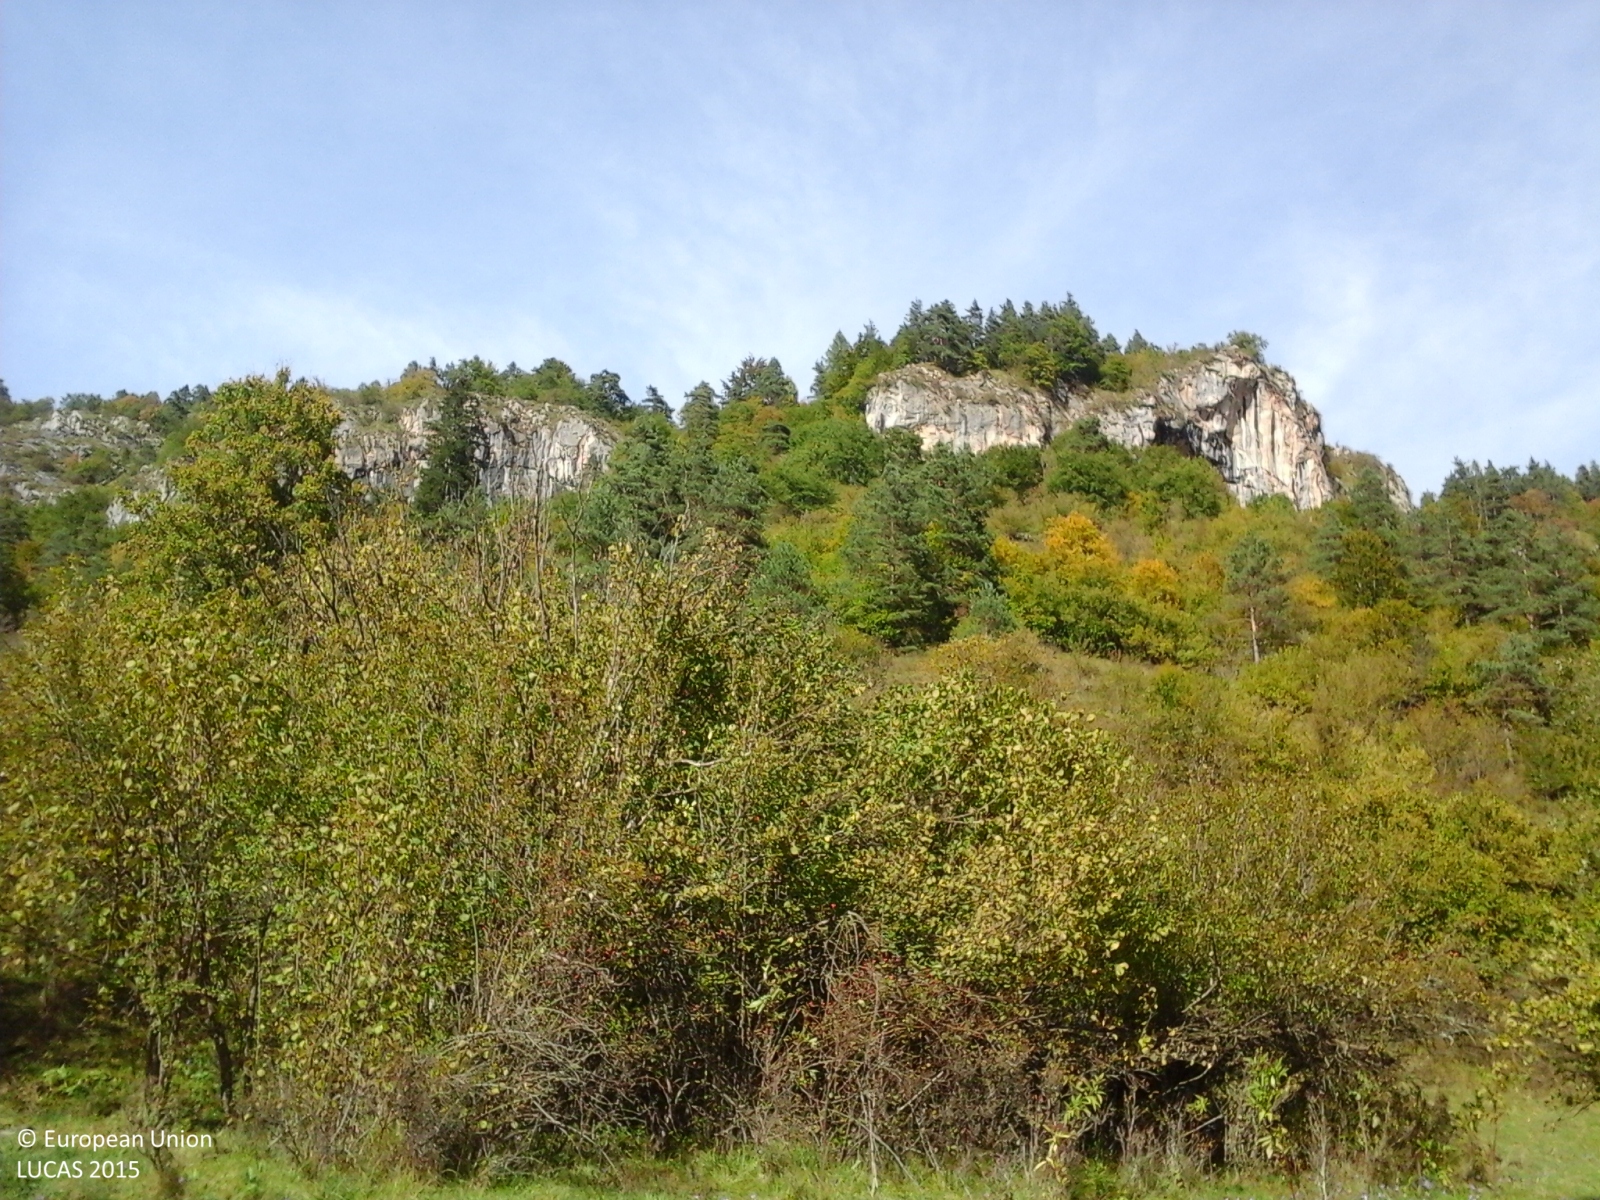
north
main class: Woodland
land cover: Broadleaved woodland
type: thermophilous deciduous forest
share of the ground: > 75 %
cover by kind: broadleaved forest trees 70 %, herbaceous plants 20 %, consolidated bare surface 10 %
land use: Semi-natural and natural areas not in use
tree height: < 5 m
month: October
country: IT
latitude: 44.1106
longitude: 7.7936
